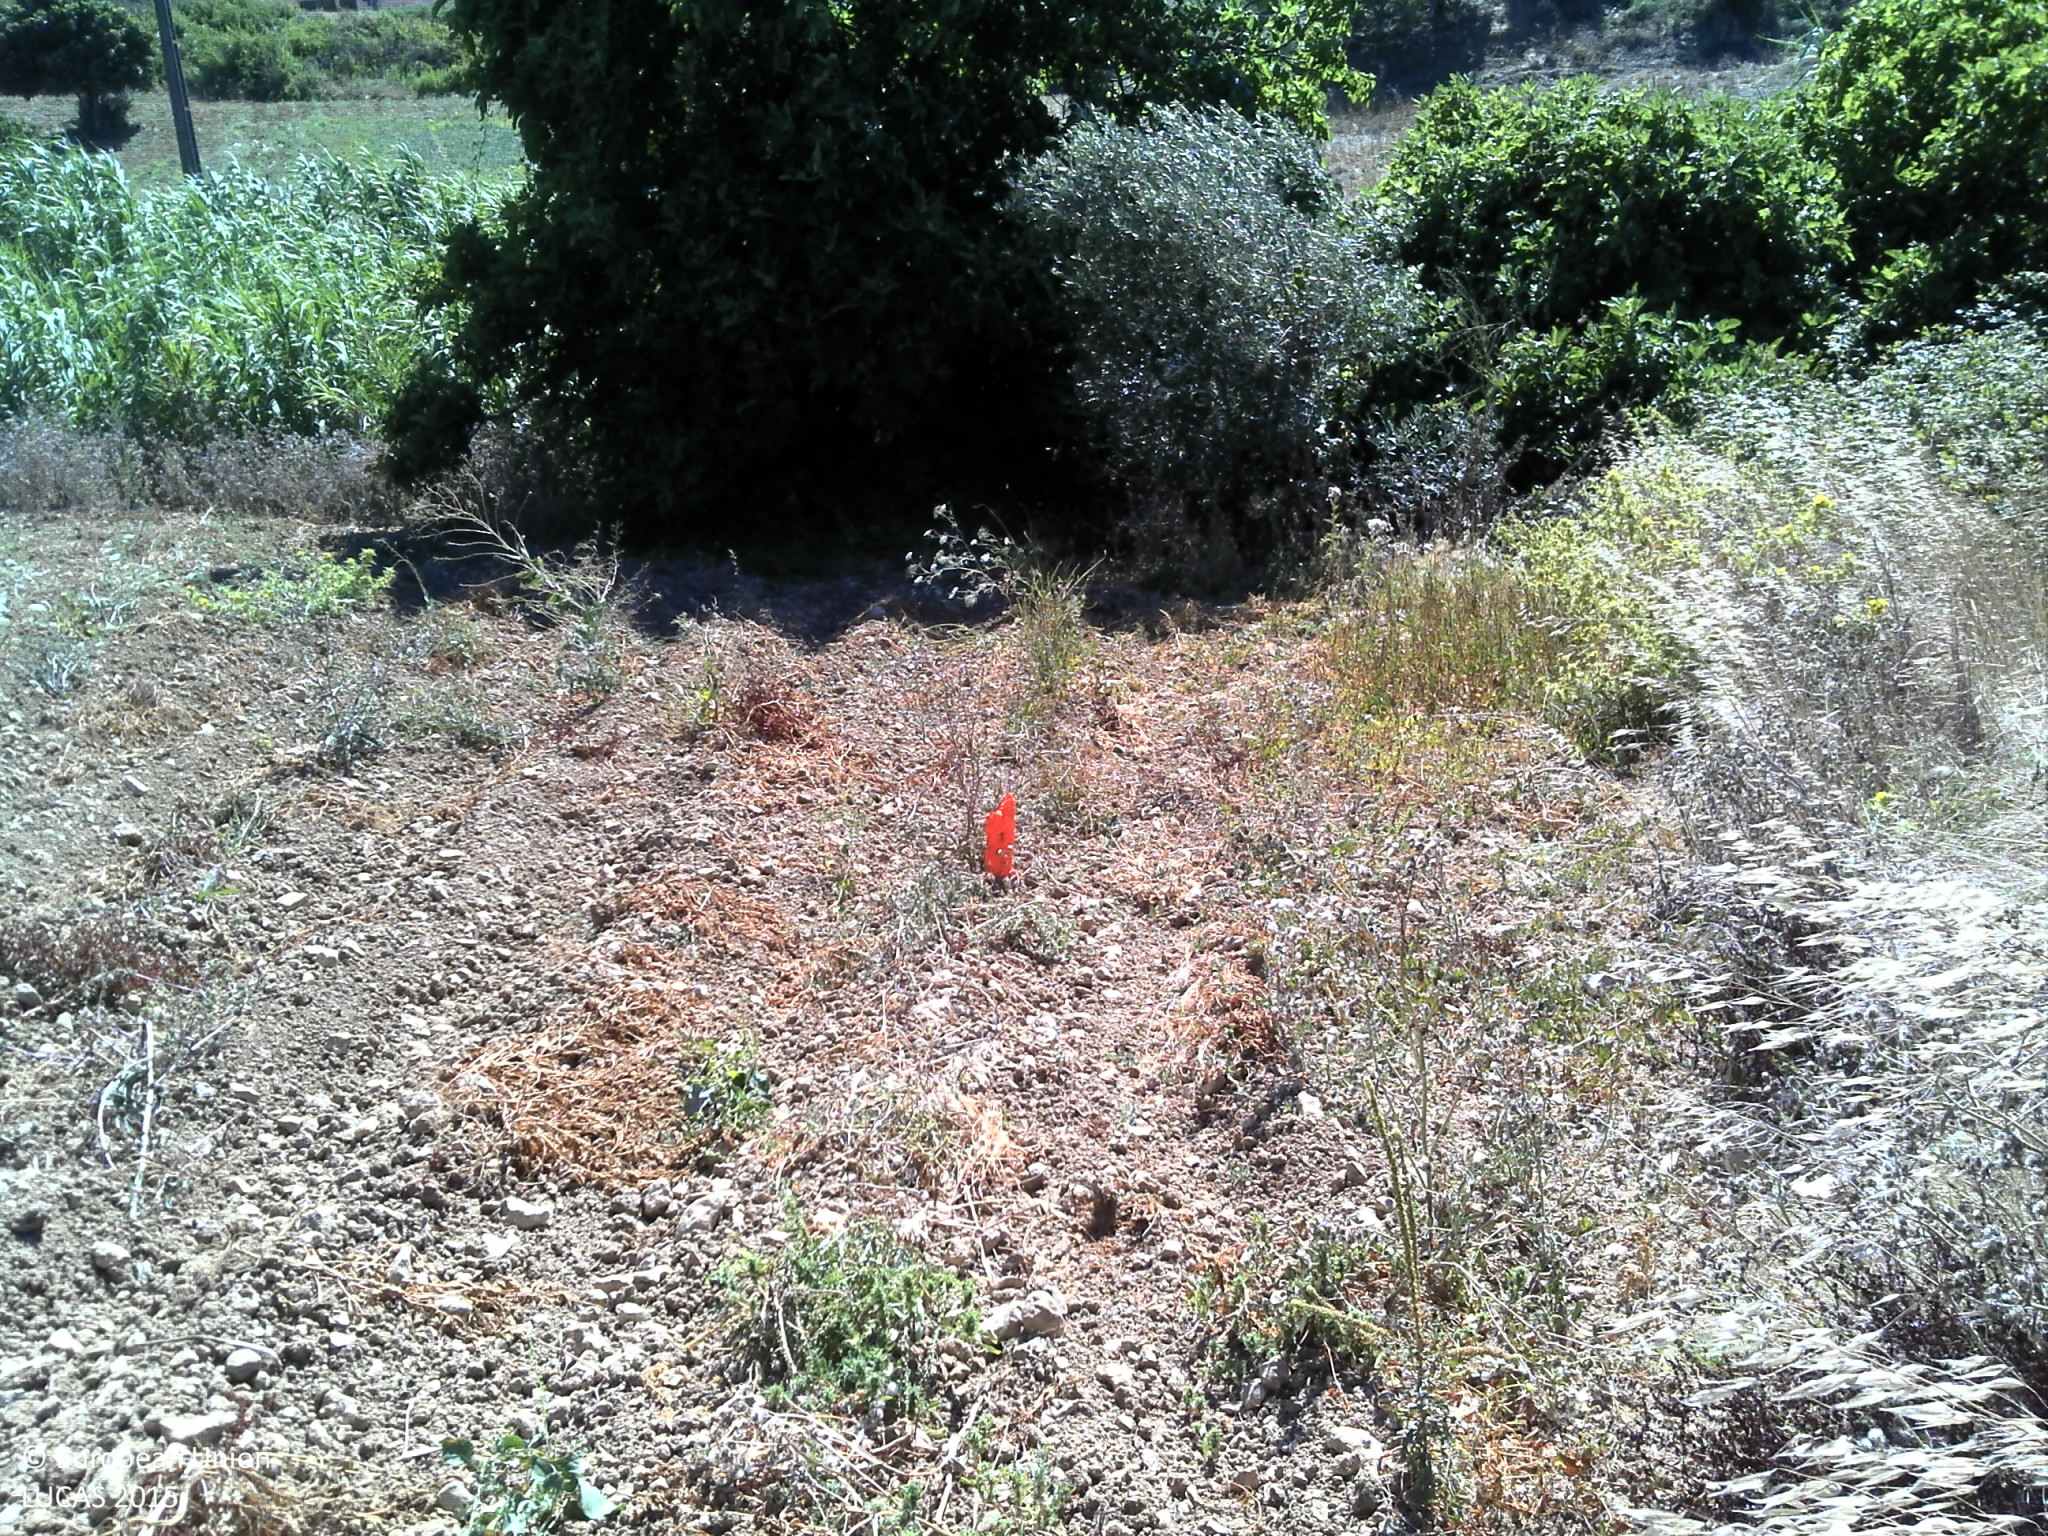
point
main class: Grassland
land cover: Spontaneously vegetated surfaces
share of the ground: 10 - 25 %
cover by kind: unconsolidated bare surface 75 %, herbaceous plants 15 %
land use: Fallow land
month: July
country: PT
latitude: 38.9835
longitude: -9.1873
